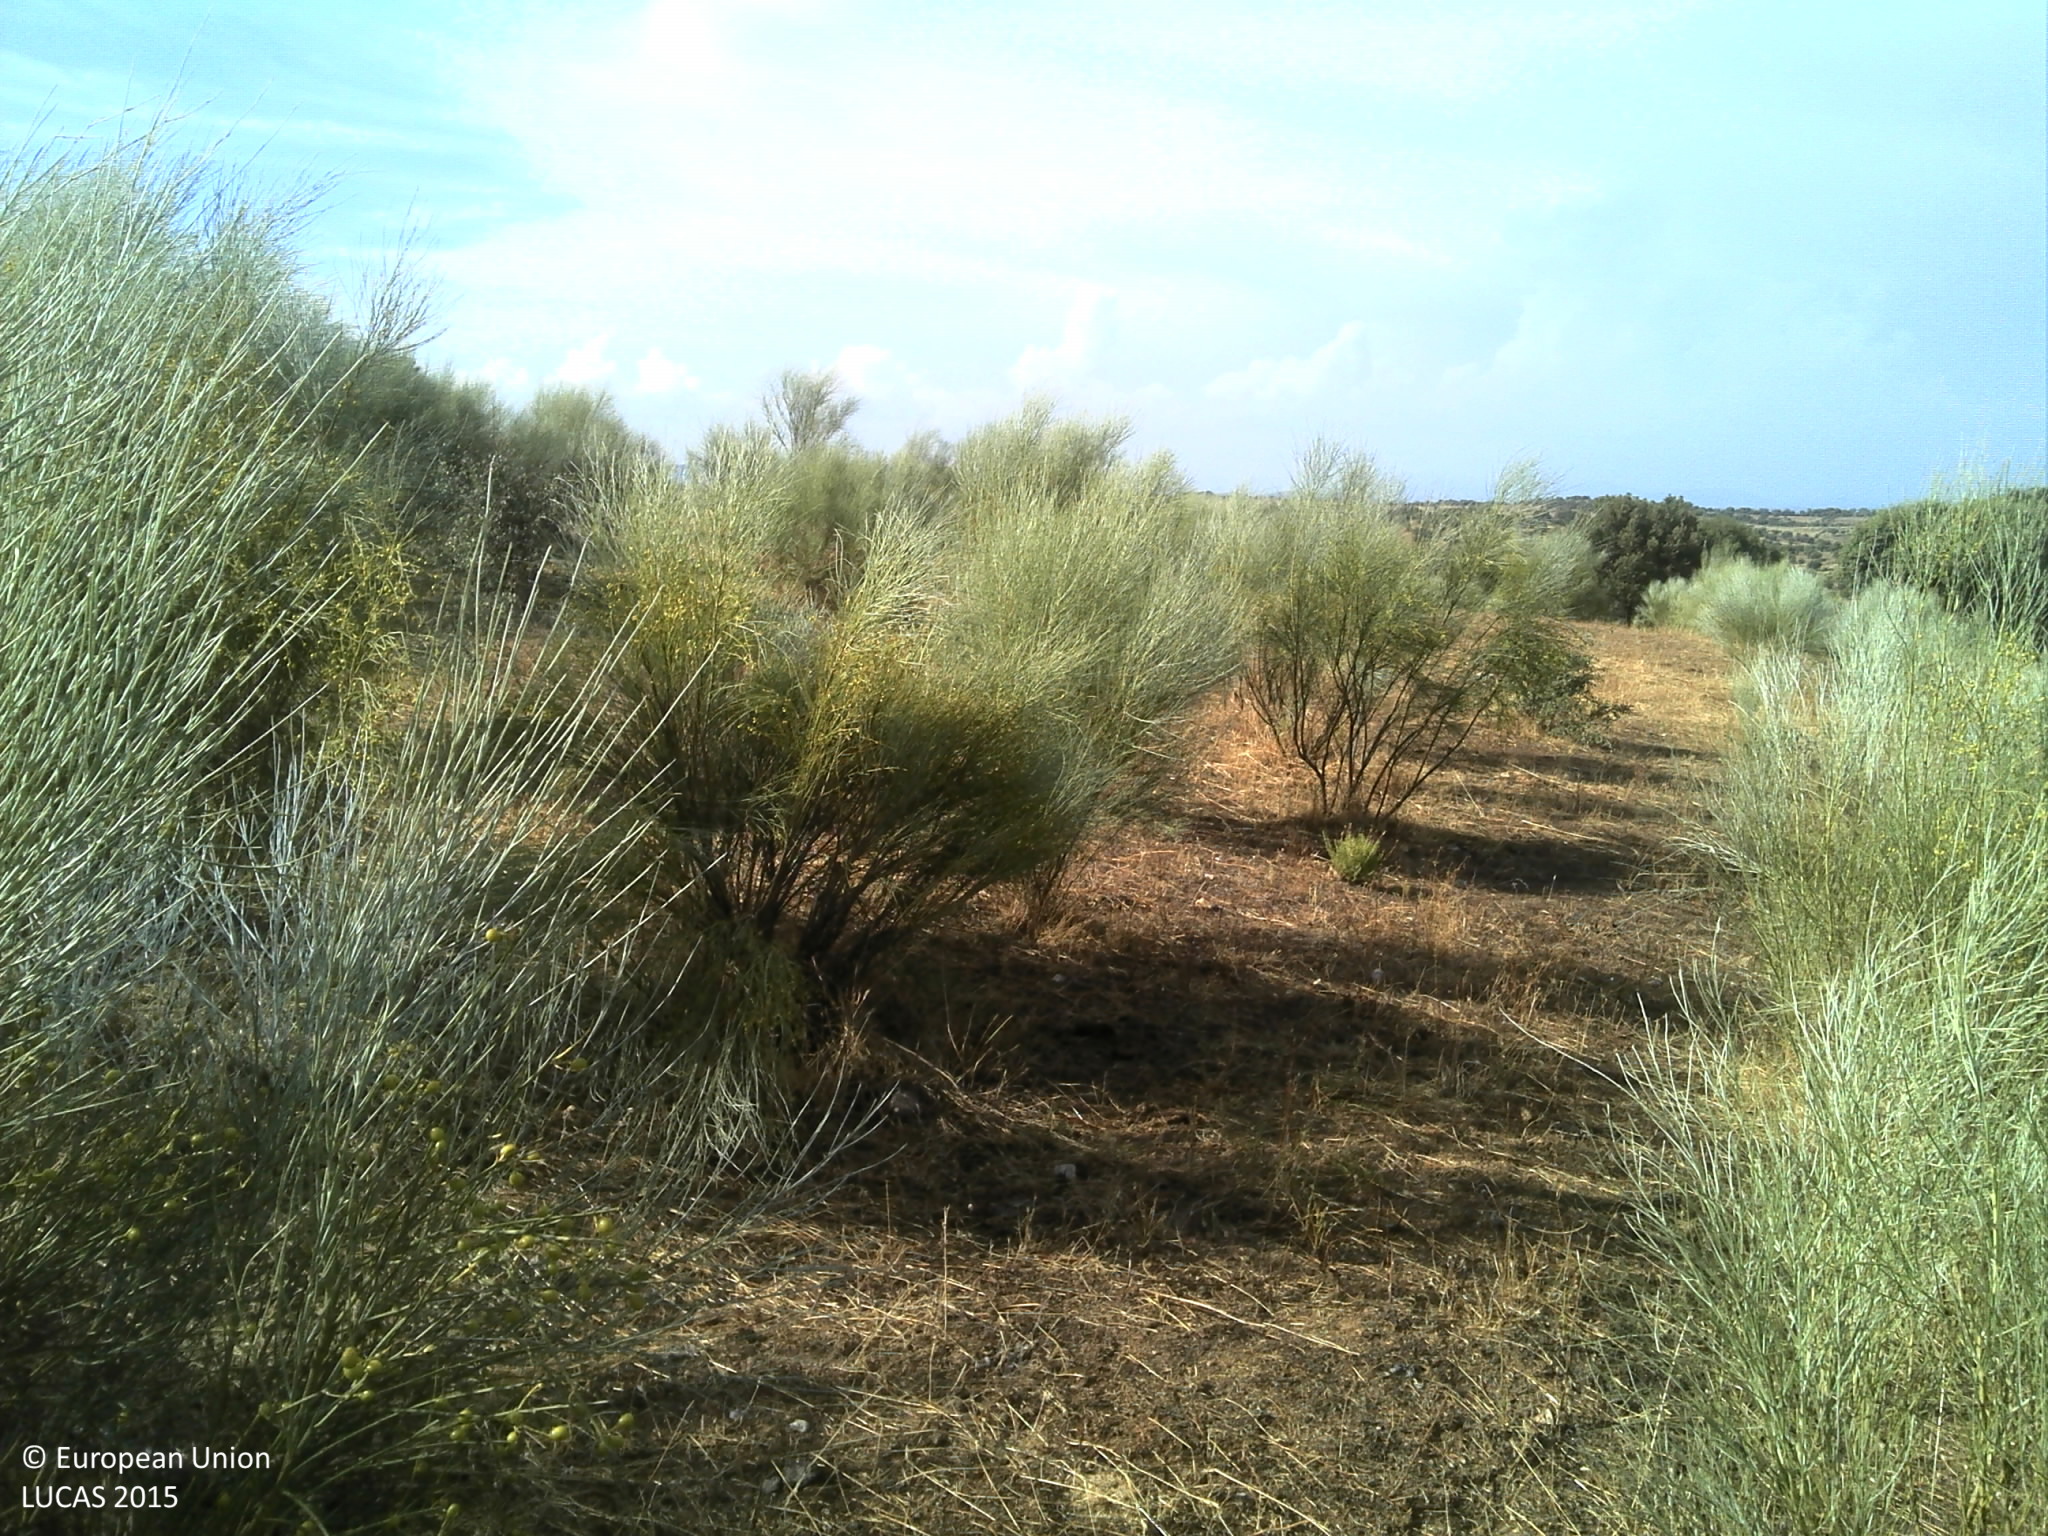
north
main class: Woodland
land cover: Broadleaved woodland
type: broadleaved evergreen forest
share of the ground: 10 - 25 %
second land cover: Grassland without tree/shrub cover
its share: 25 - 50 %
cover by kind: unconsolidated bare surface 45 %, herbaceous plants 30 %, broadleaved forest trees 15 %, shrubs 10 %
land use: Forestry
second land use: Agriculture (excluding fallow land and kitchen gardens)
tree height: > 5 m
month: June
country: PT
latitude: 39.8670
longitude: -6.9568
